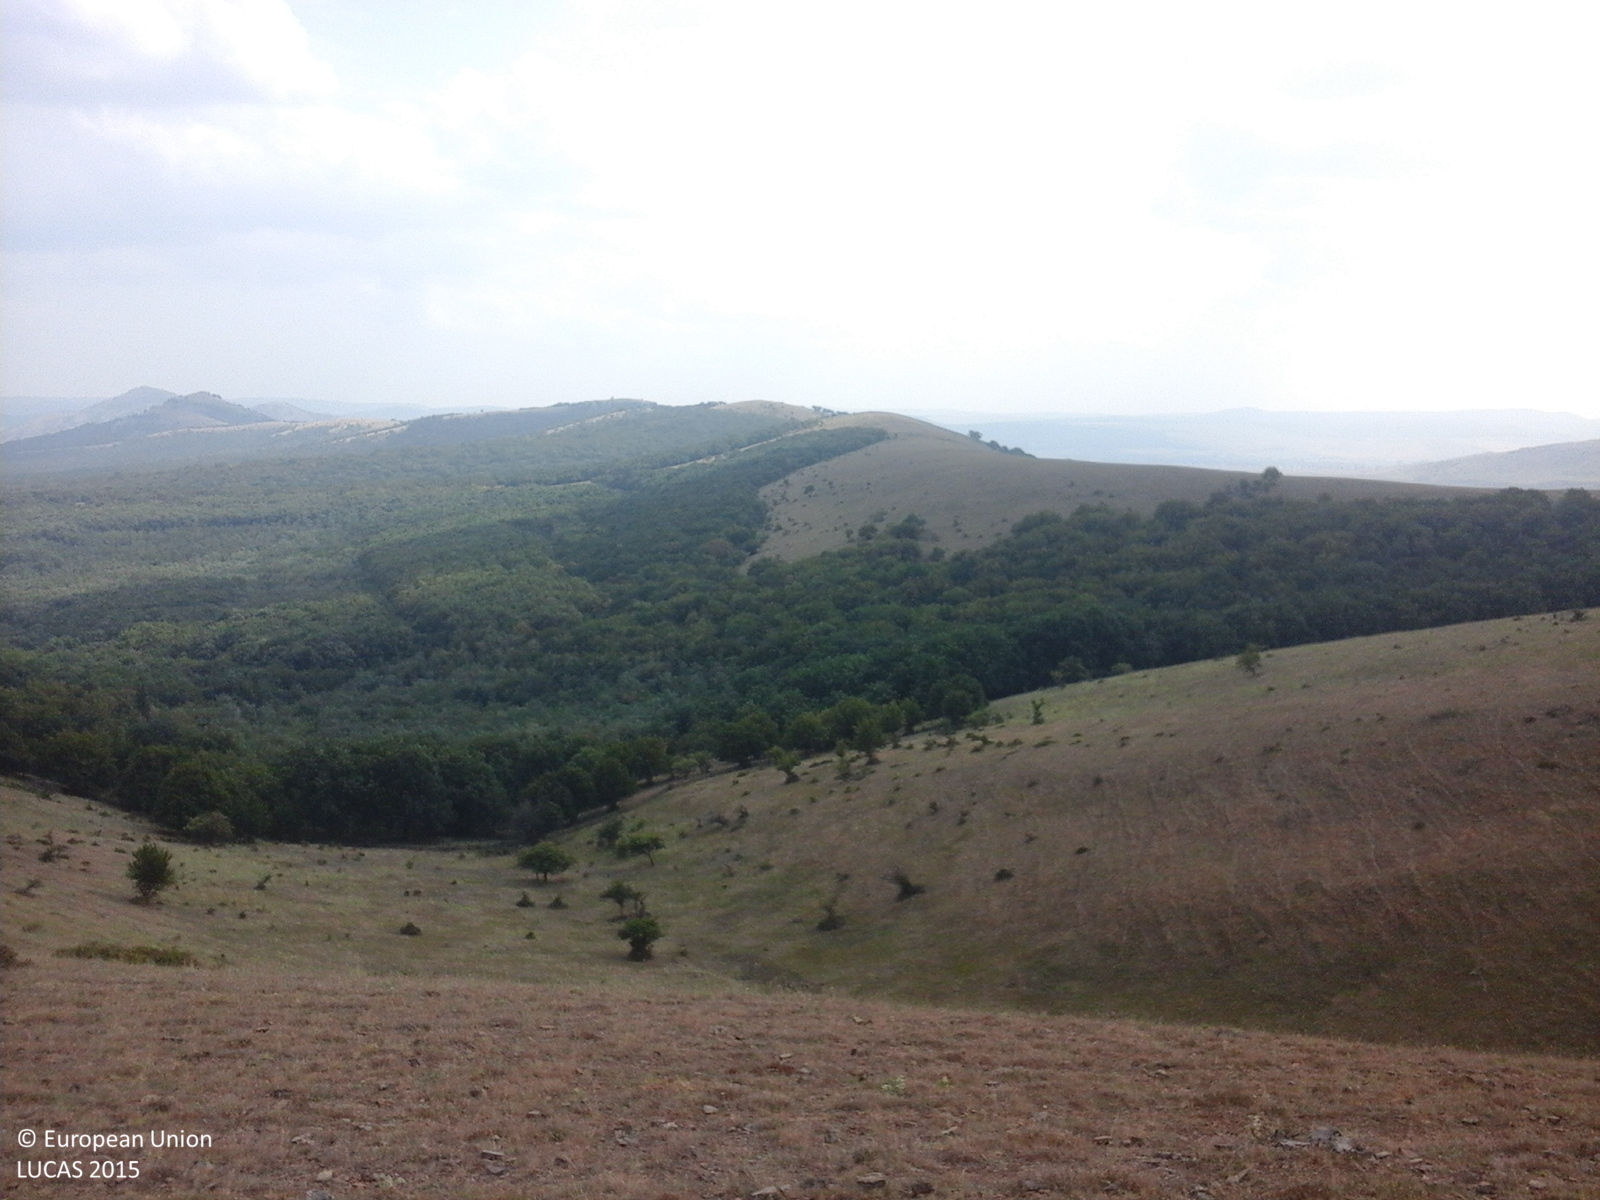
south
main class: Grassland
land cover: Grassland without tree/shrub cover
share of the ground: > 75 %
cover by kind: herbaceous plants 80 %, unconsolidated bare surface 20 %
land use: Agriculture (excluding fallow land and kitchen gardens)
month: July
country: RO
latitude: 45.0901
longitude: 28.4893
